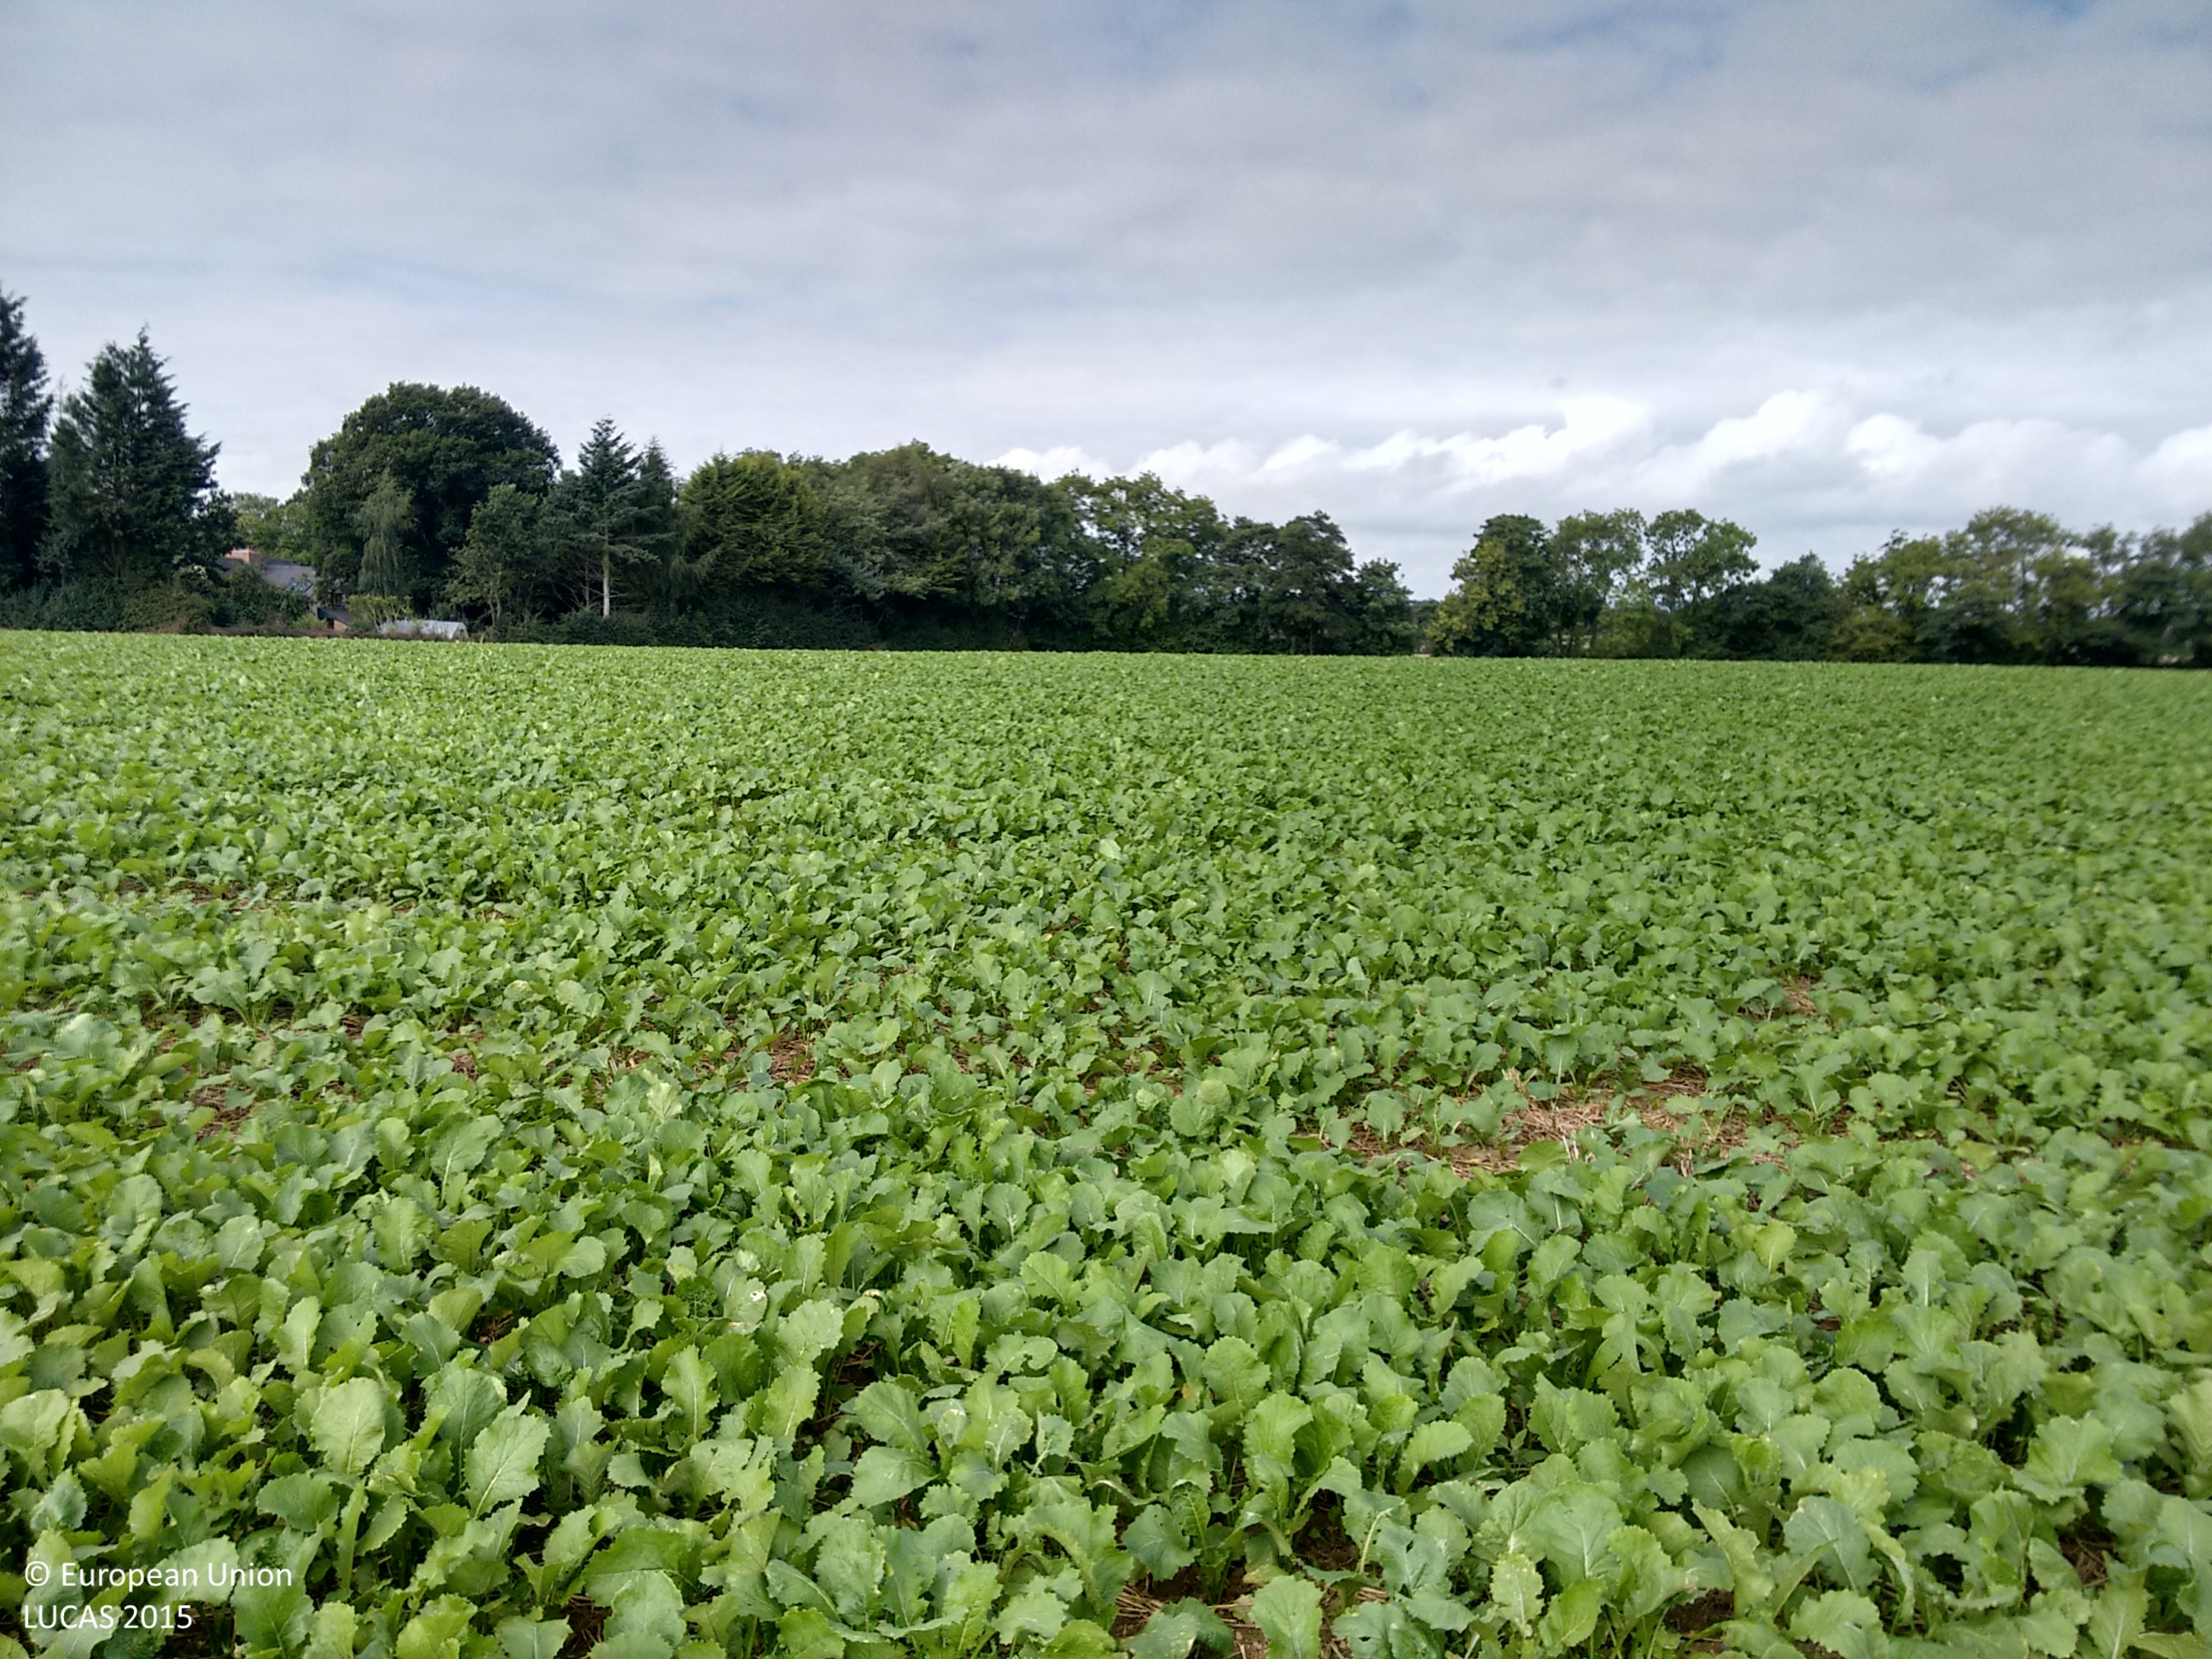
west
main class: Cropland
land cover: Sugar beet
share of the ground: > 75 %
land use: Agriculture (excluding fallow land and kitchen gardens)
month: September
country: GB
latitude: 52.8456
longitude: -2.9769
